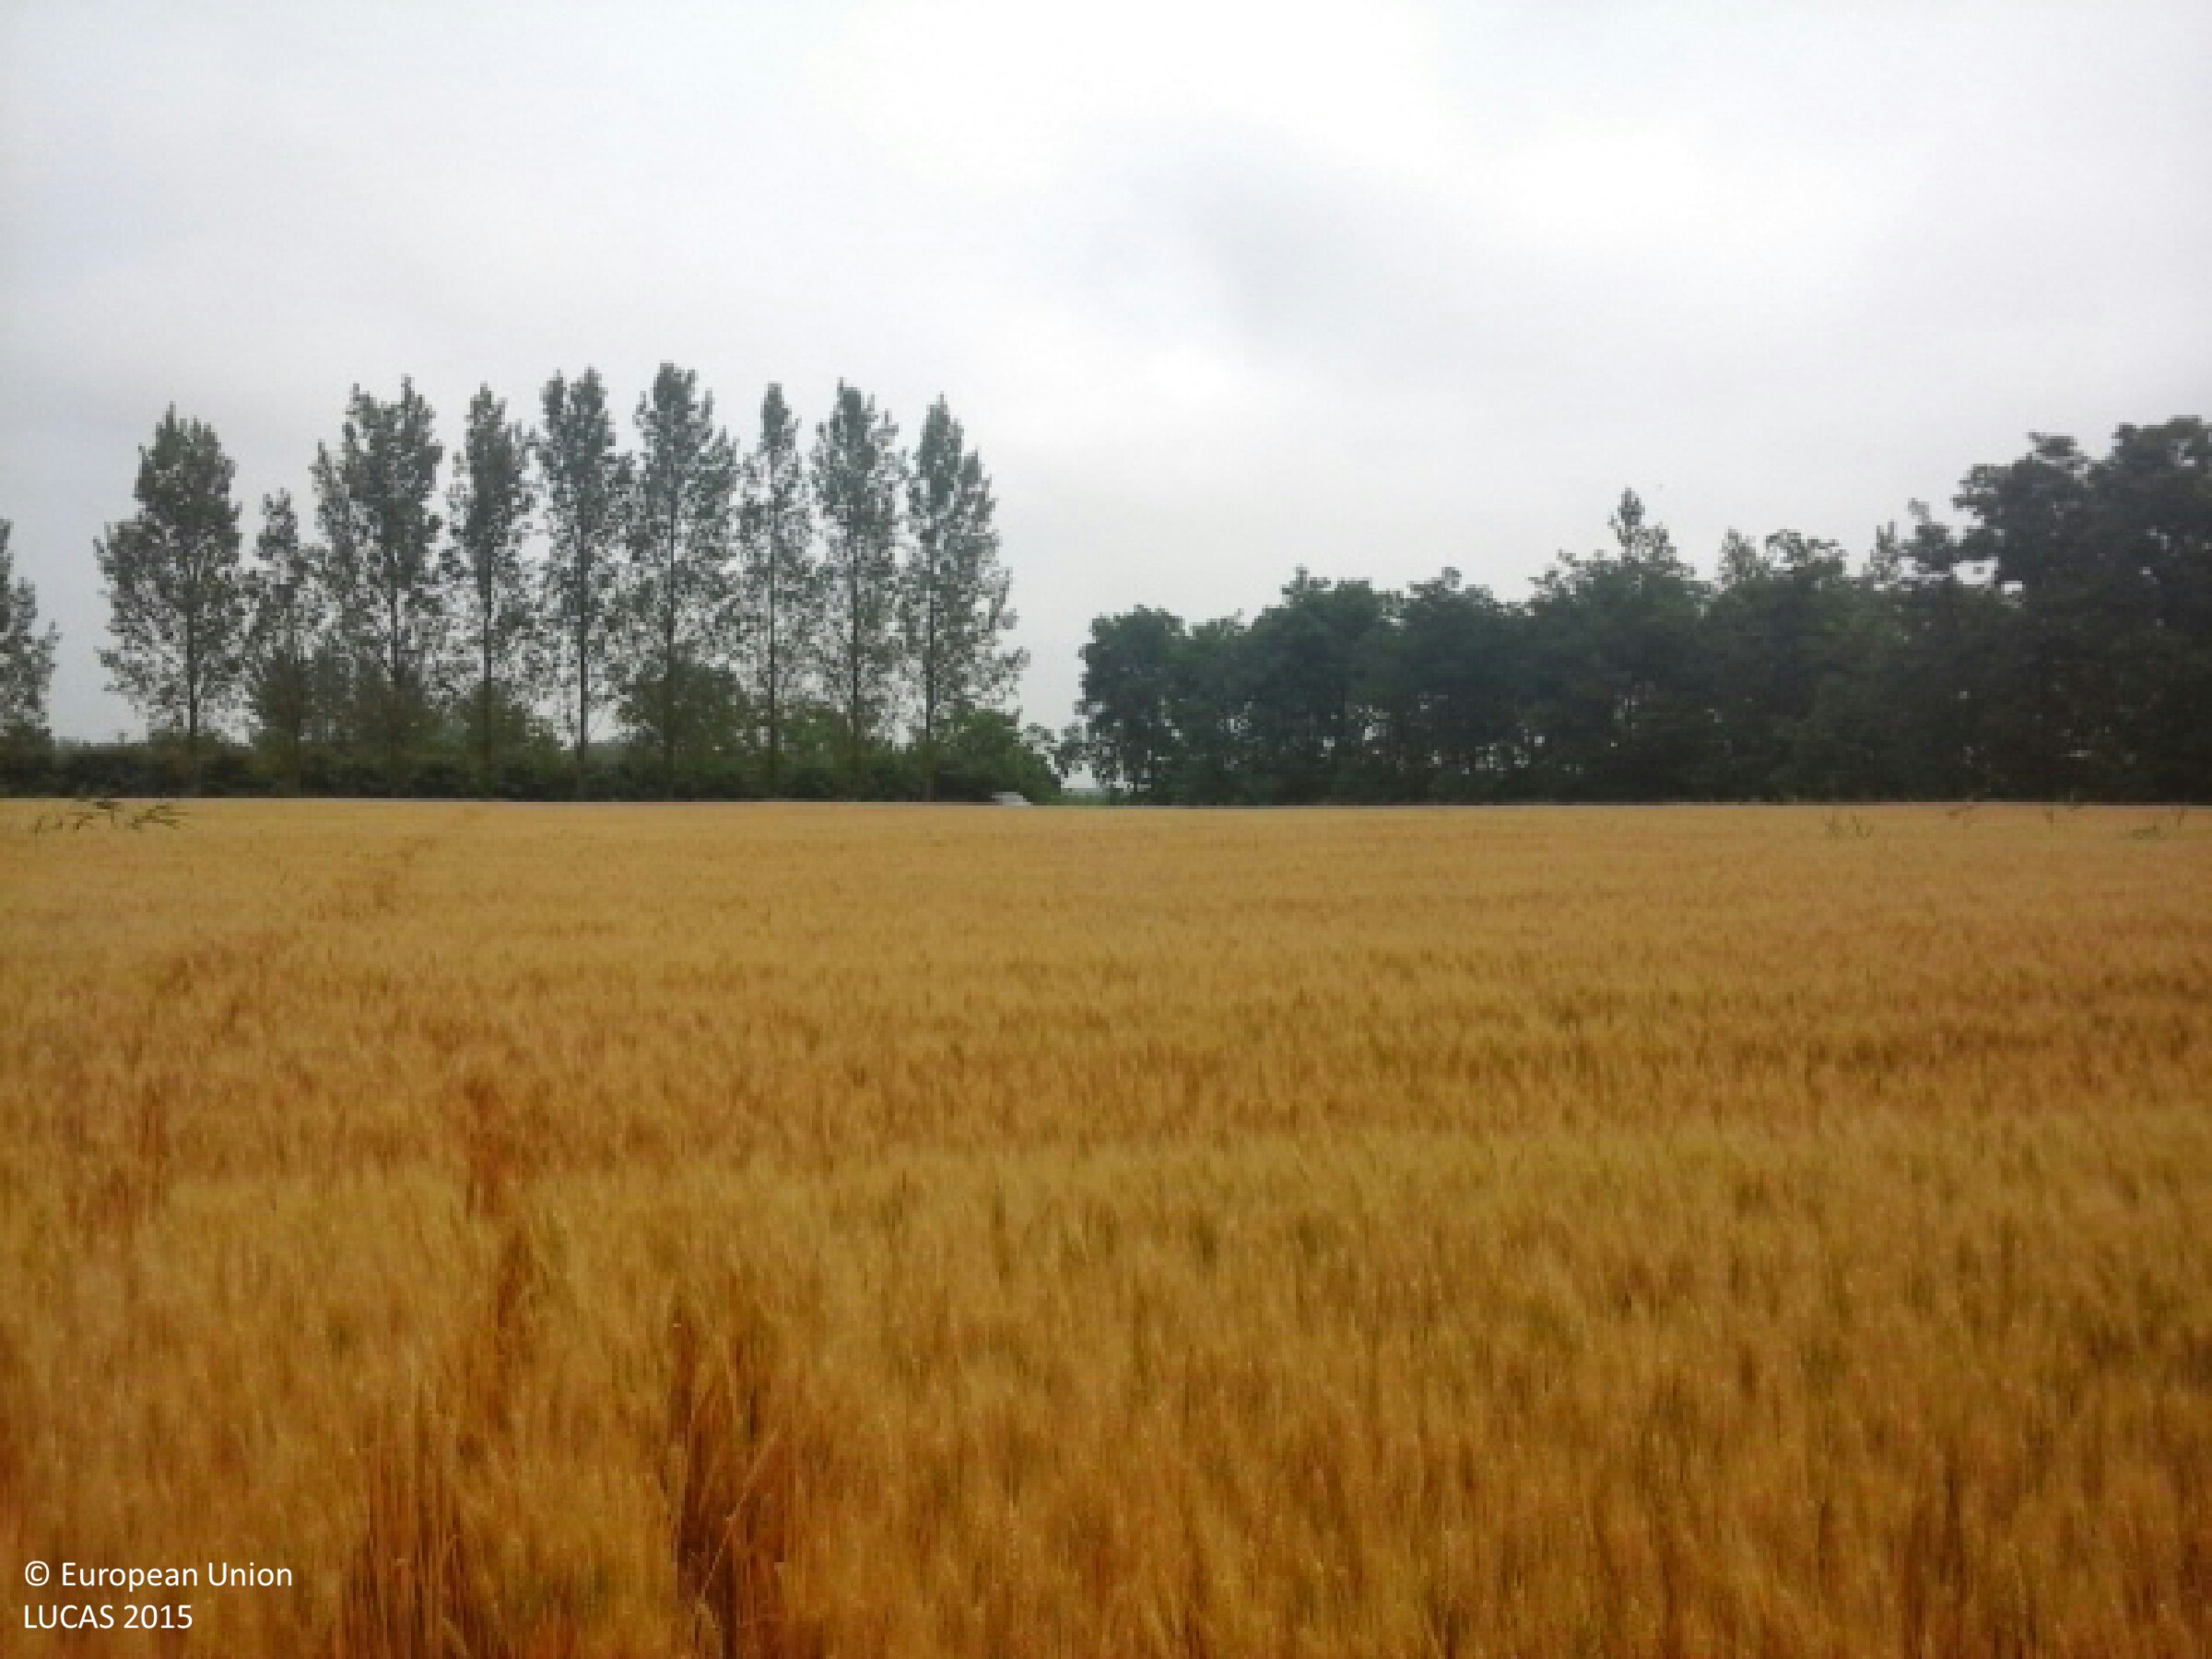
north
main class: Cropland
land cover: Triticale
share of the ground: > 75 %
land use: Agriculture (excluding fallow land and kitchen gardens)
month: June
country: HU
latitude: 48.0994
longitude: 21.7722
